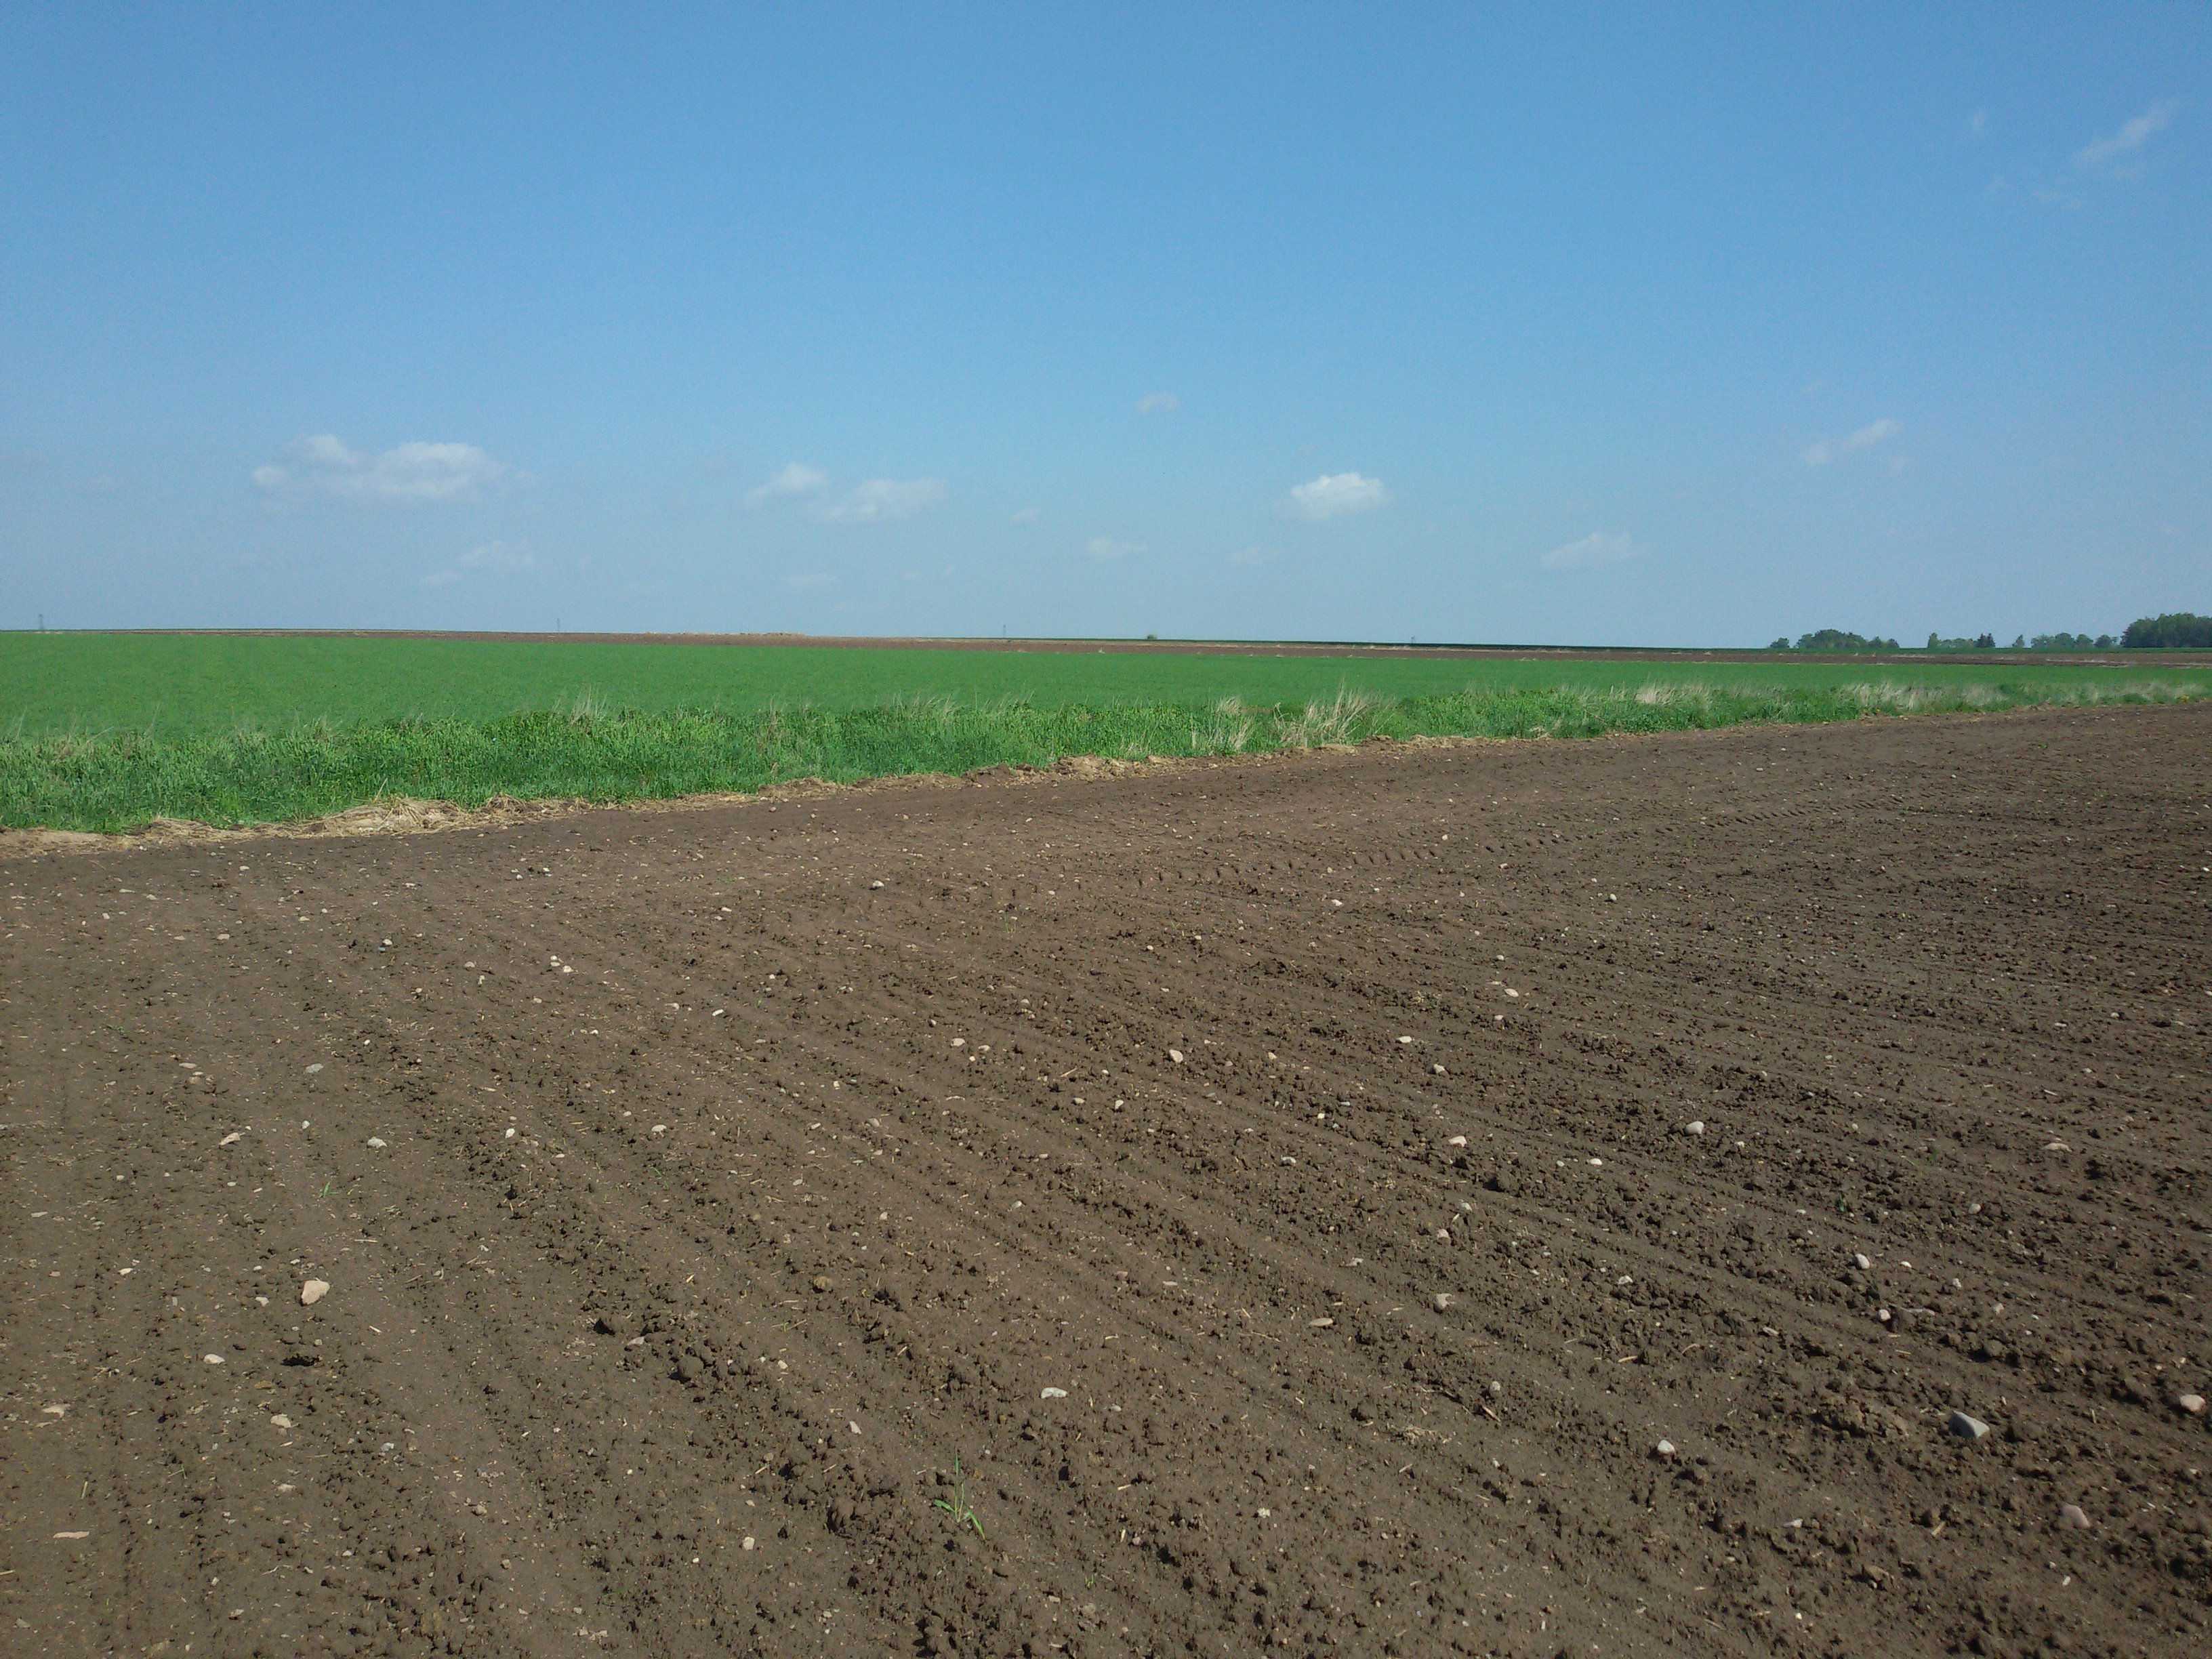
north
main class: Cropland
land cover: Maize
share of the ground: < 10 %
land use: Agriculture (excluding fallow land and kitchen gardens)
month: May
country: PL
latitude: 53.0647
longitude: 22.2842
